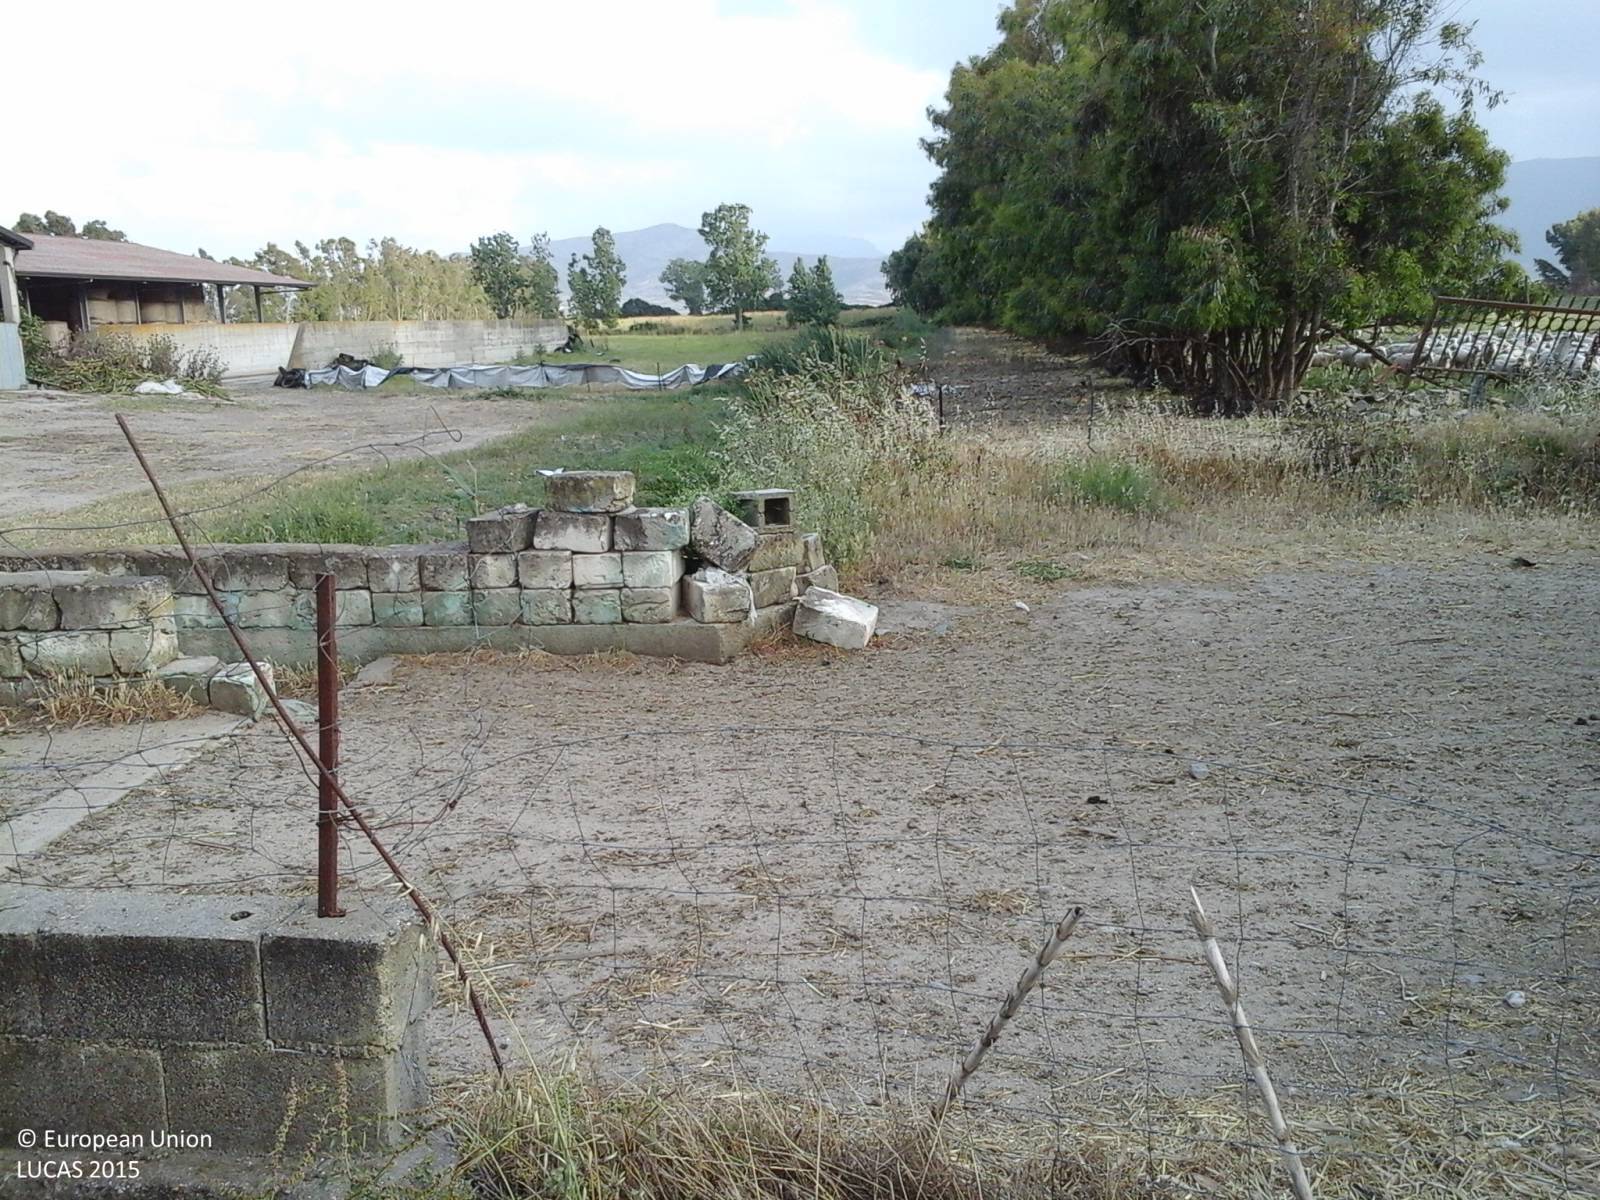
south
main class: Cropland
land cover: Clovers
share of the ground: > 75 %
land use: Agriculture (excluding fallow land and kitchen gardens)
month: May
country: IT
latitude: 39.7133
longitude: 8.5502
